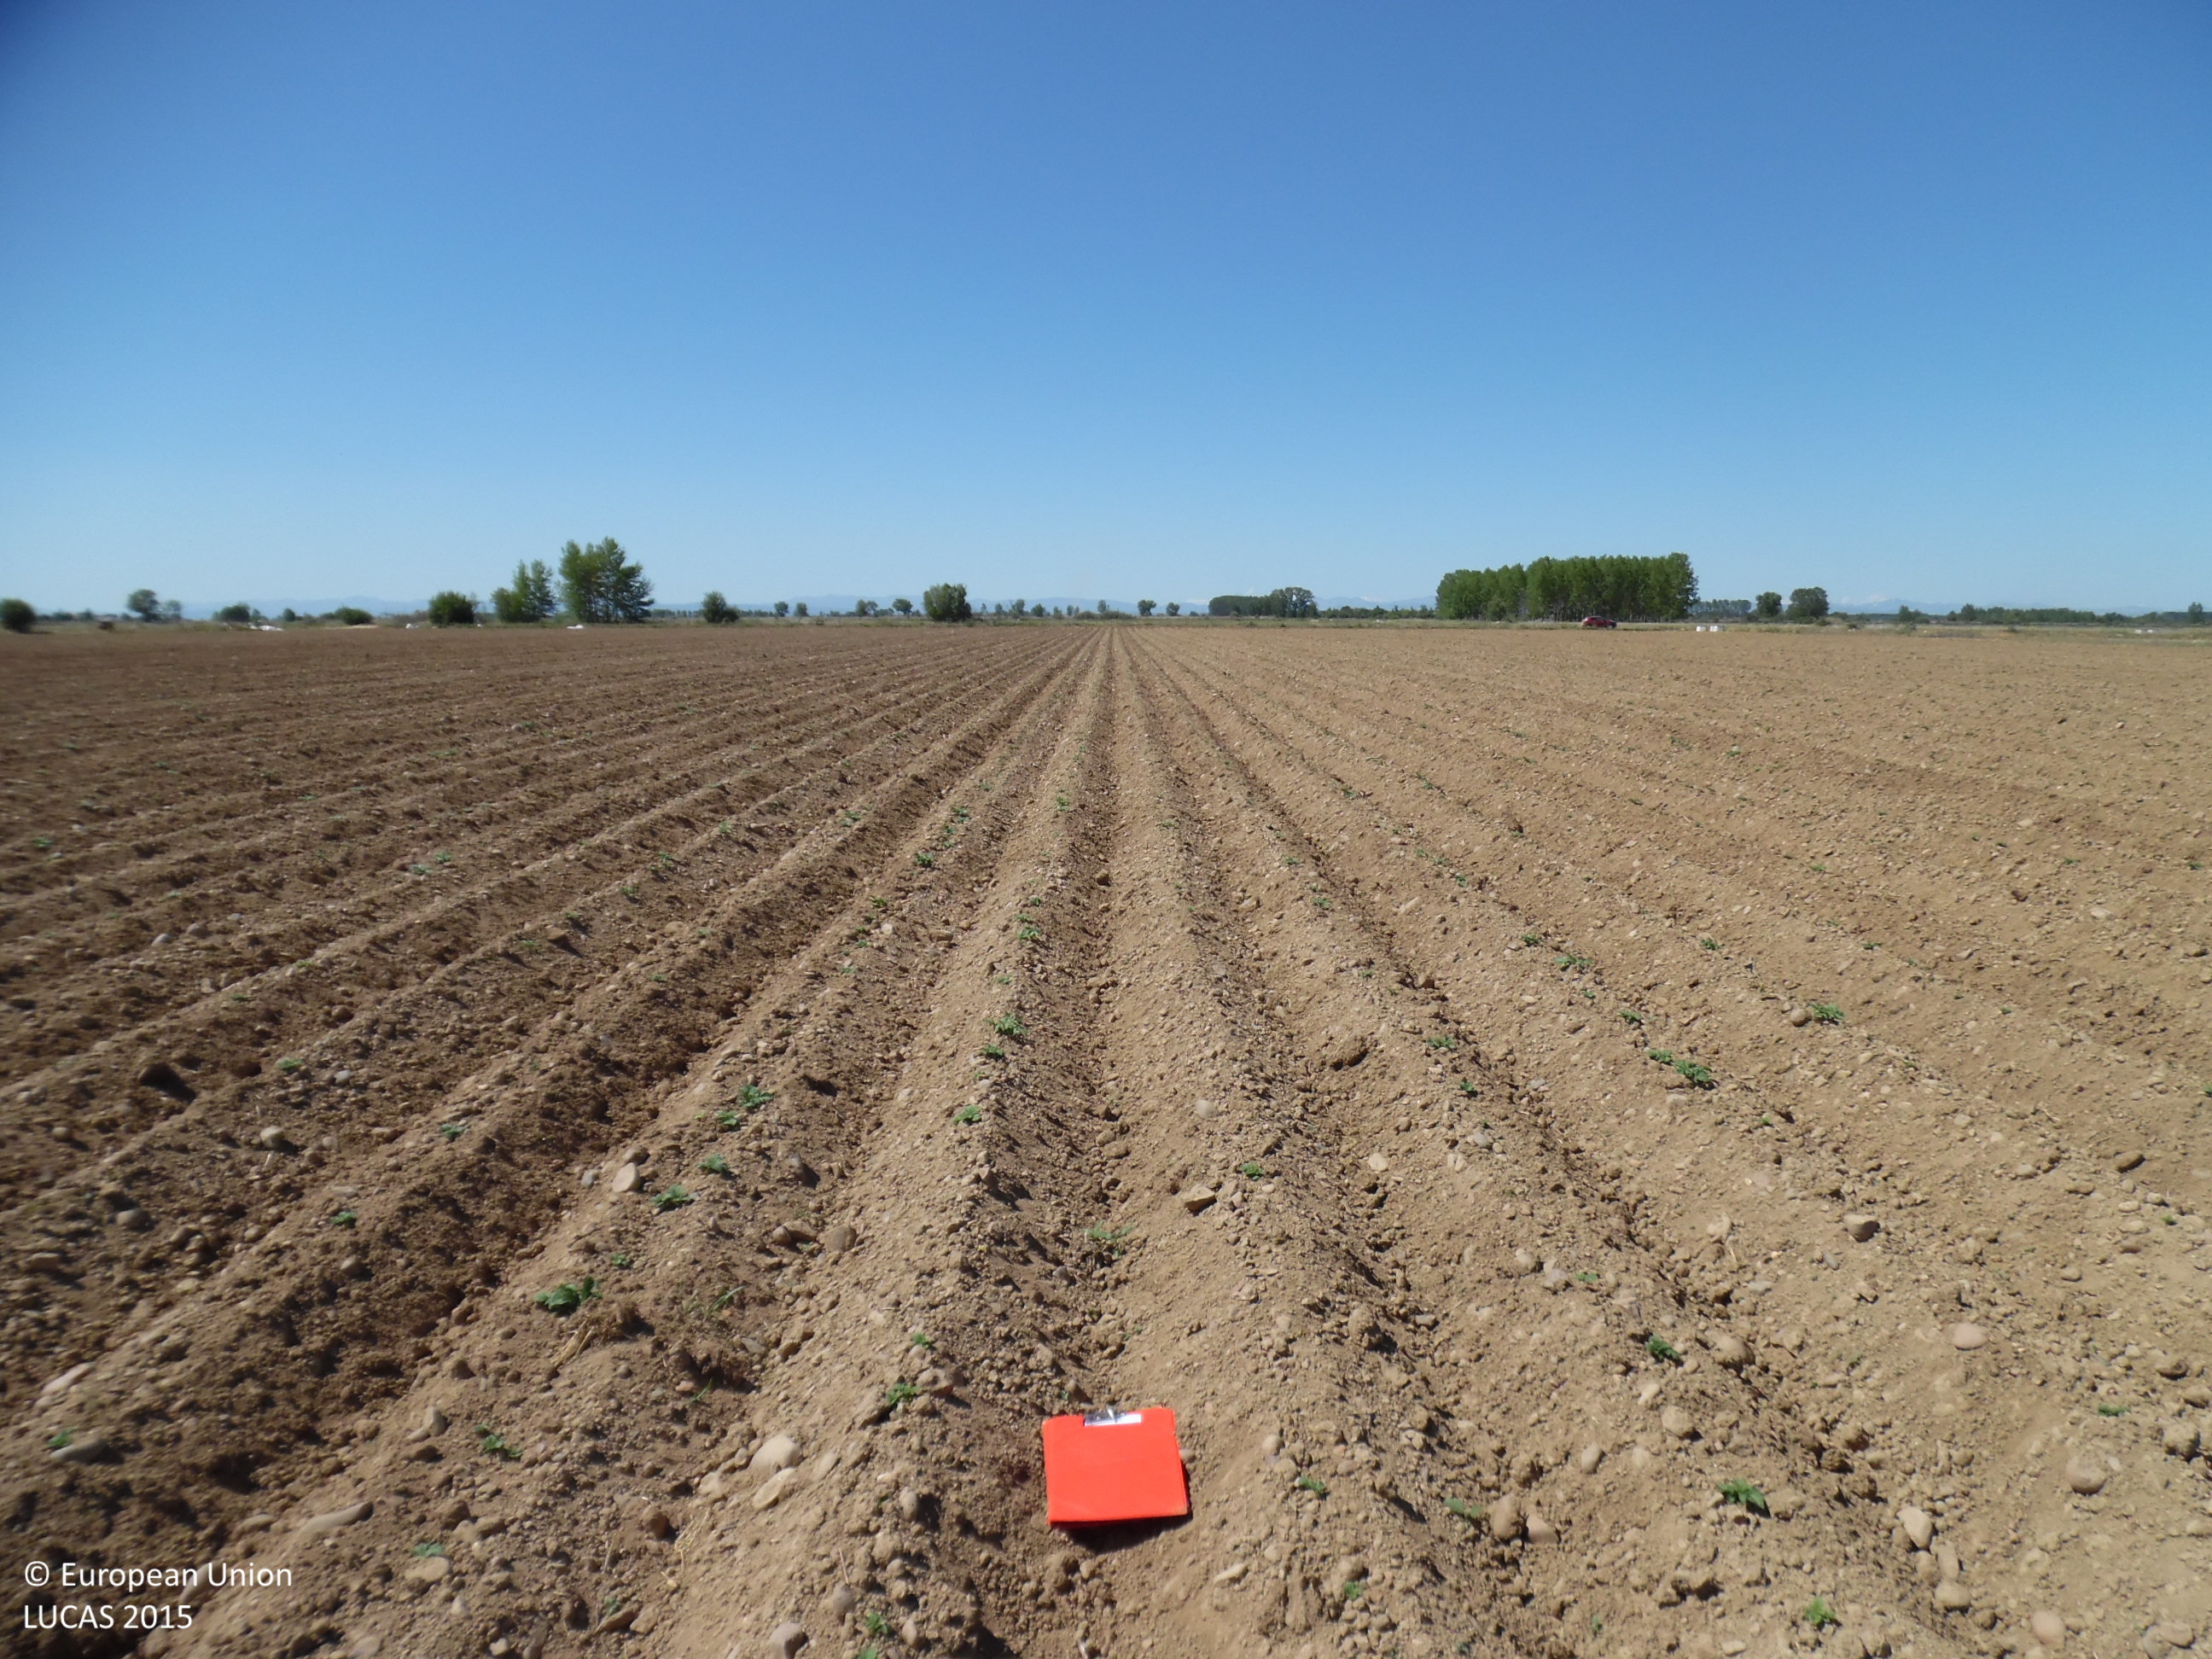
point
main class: Cropland
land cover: Potatoes
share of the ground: < 10 %
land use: Agriculture (excluding fallow land and kitchen gardens)
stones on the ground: 10 - 25 %
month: June
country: ES
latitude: 42.4280
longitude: -5.7168
